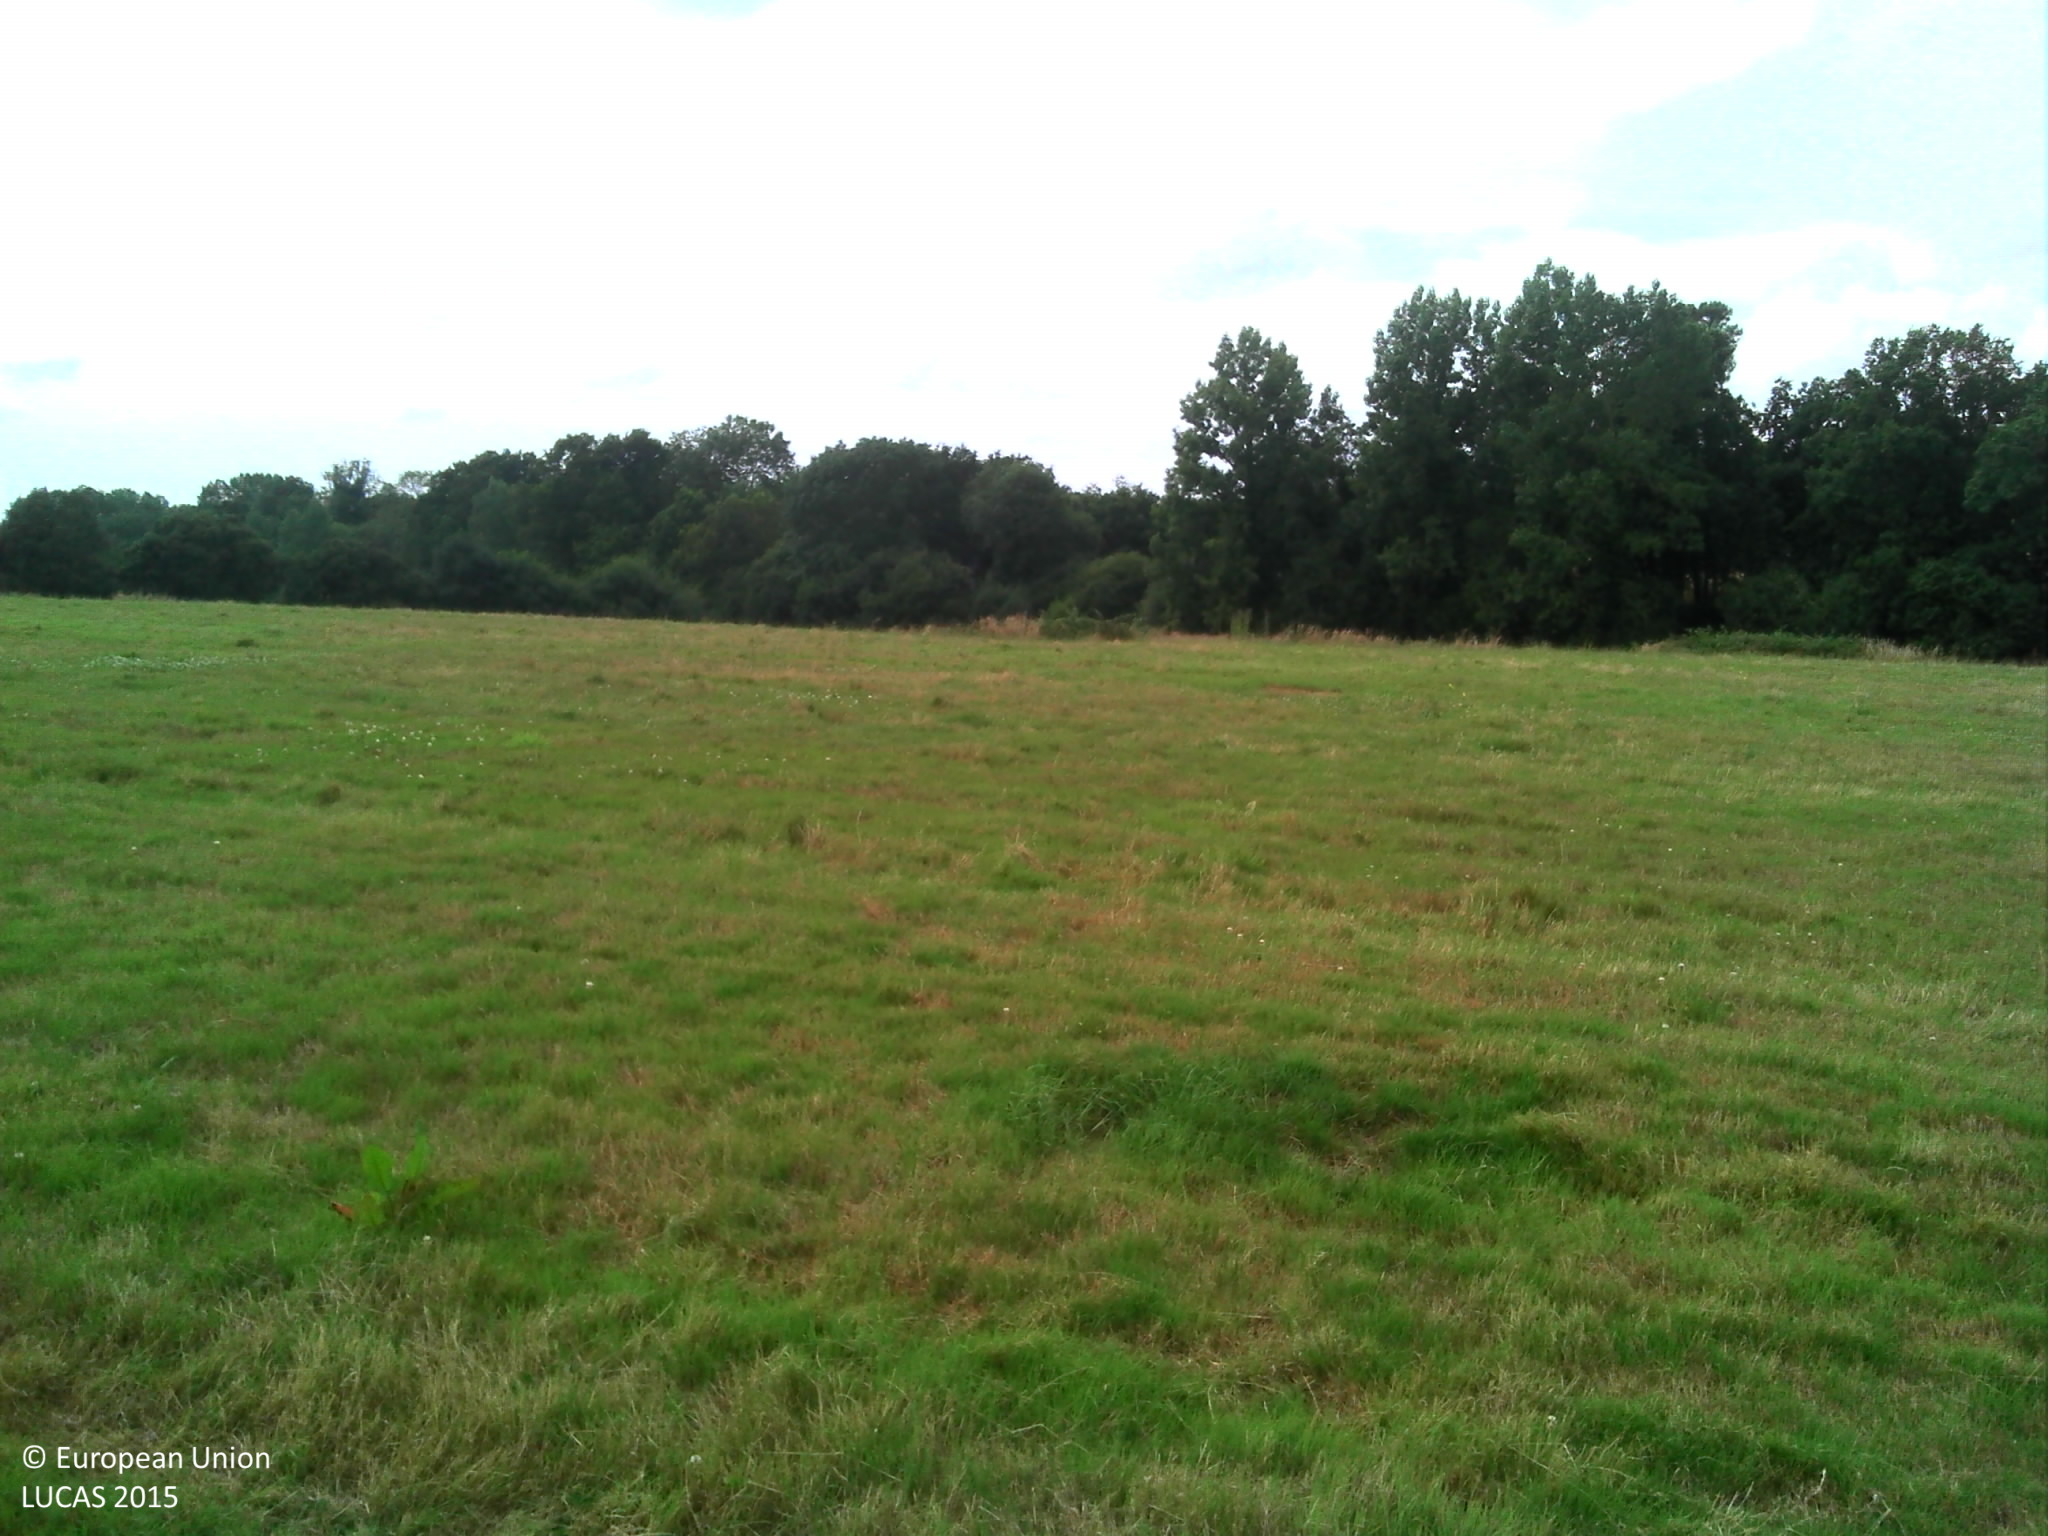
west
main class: Grassland
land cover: Grassland without tree/shrub cover
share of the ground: > 75 %
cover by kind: herbaceous plants 100 %
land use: Agriculture (excluding fallow land and kitchen gardens)
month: July
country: FR
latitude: 46.7140
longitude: -1.8032
